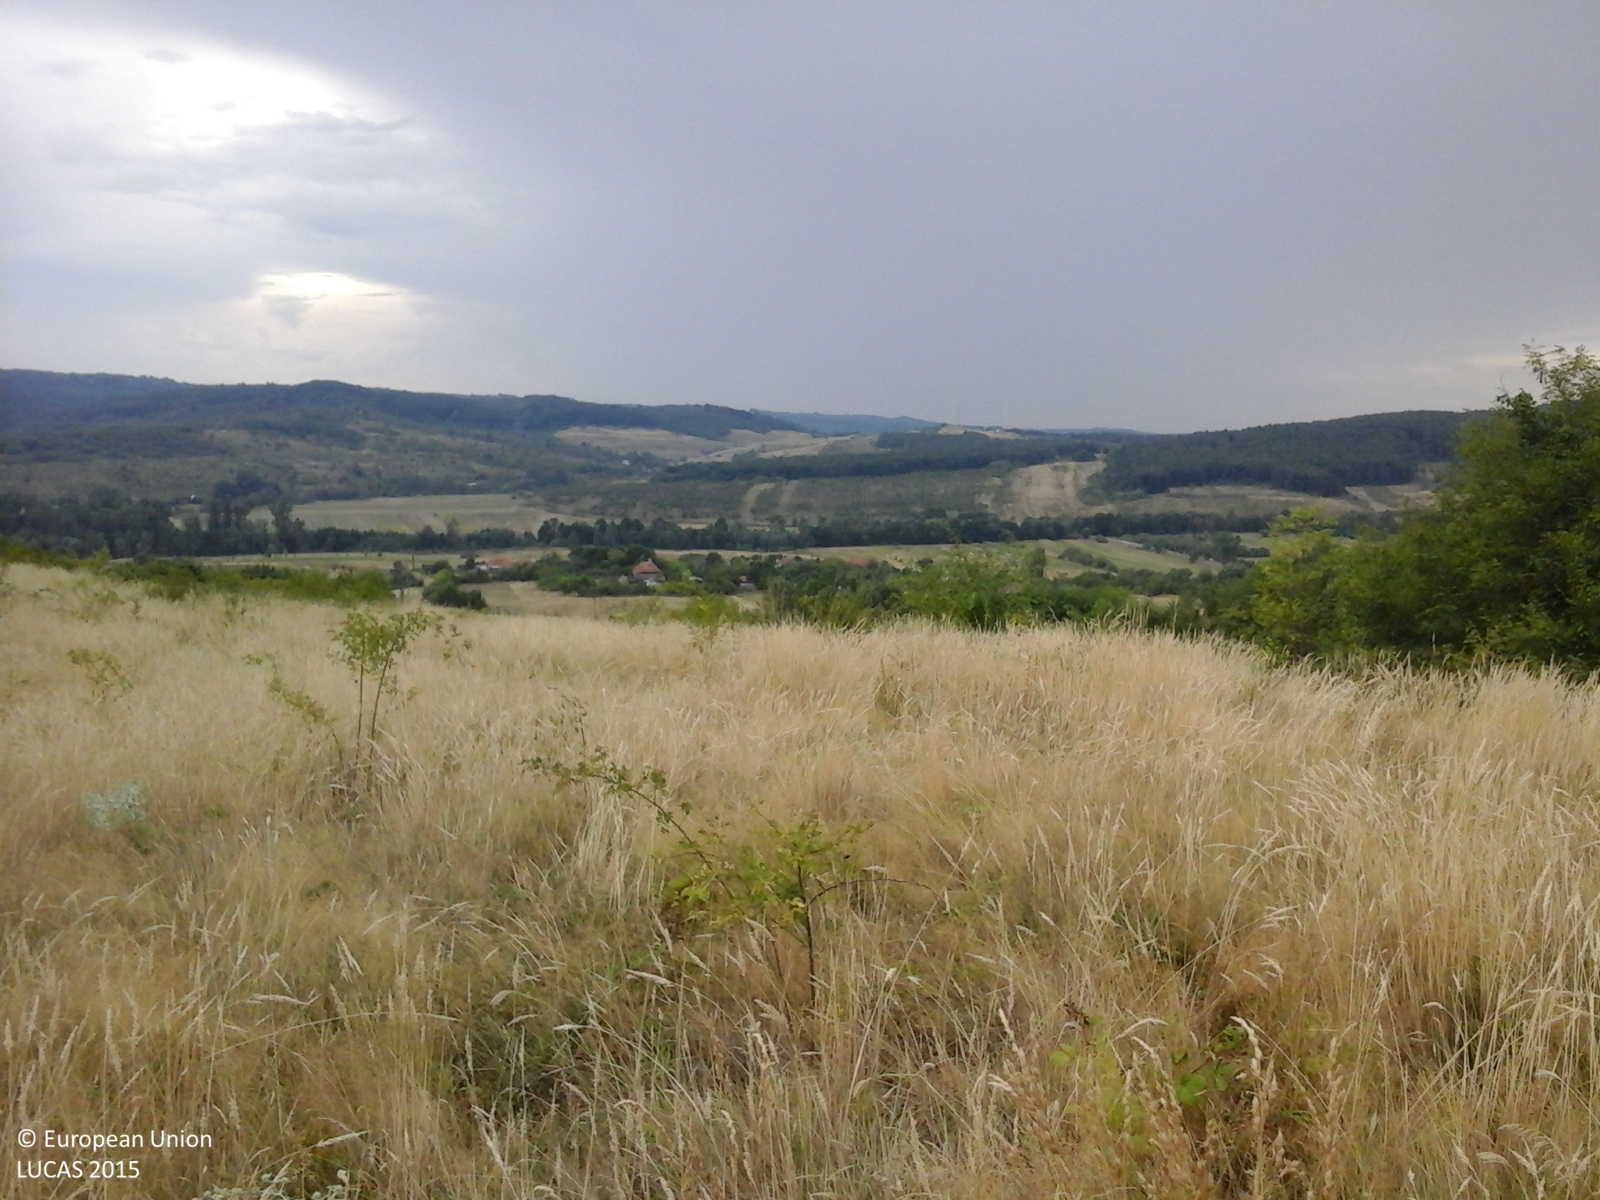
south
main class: Grassland
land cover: Grassland with sparse tree/shrub cover
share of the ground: > 75 %
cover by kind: herbaceous plants 85 %, shrubs 10 %, broadleaved forest trees 5 %
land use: Fallow land
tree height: < 5 m
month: August
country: RO
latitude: 44.7591
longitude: 22.7911
